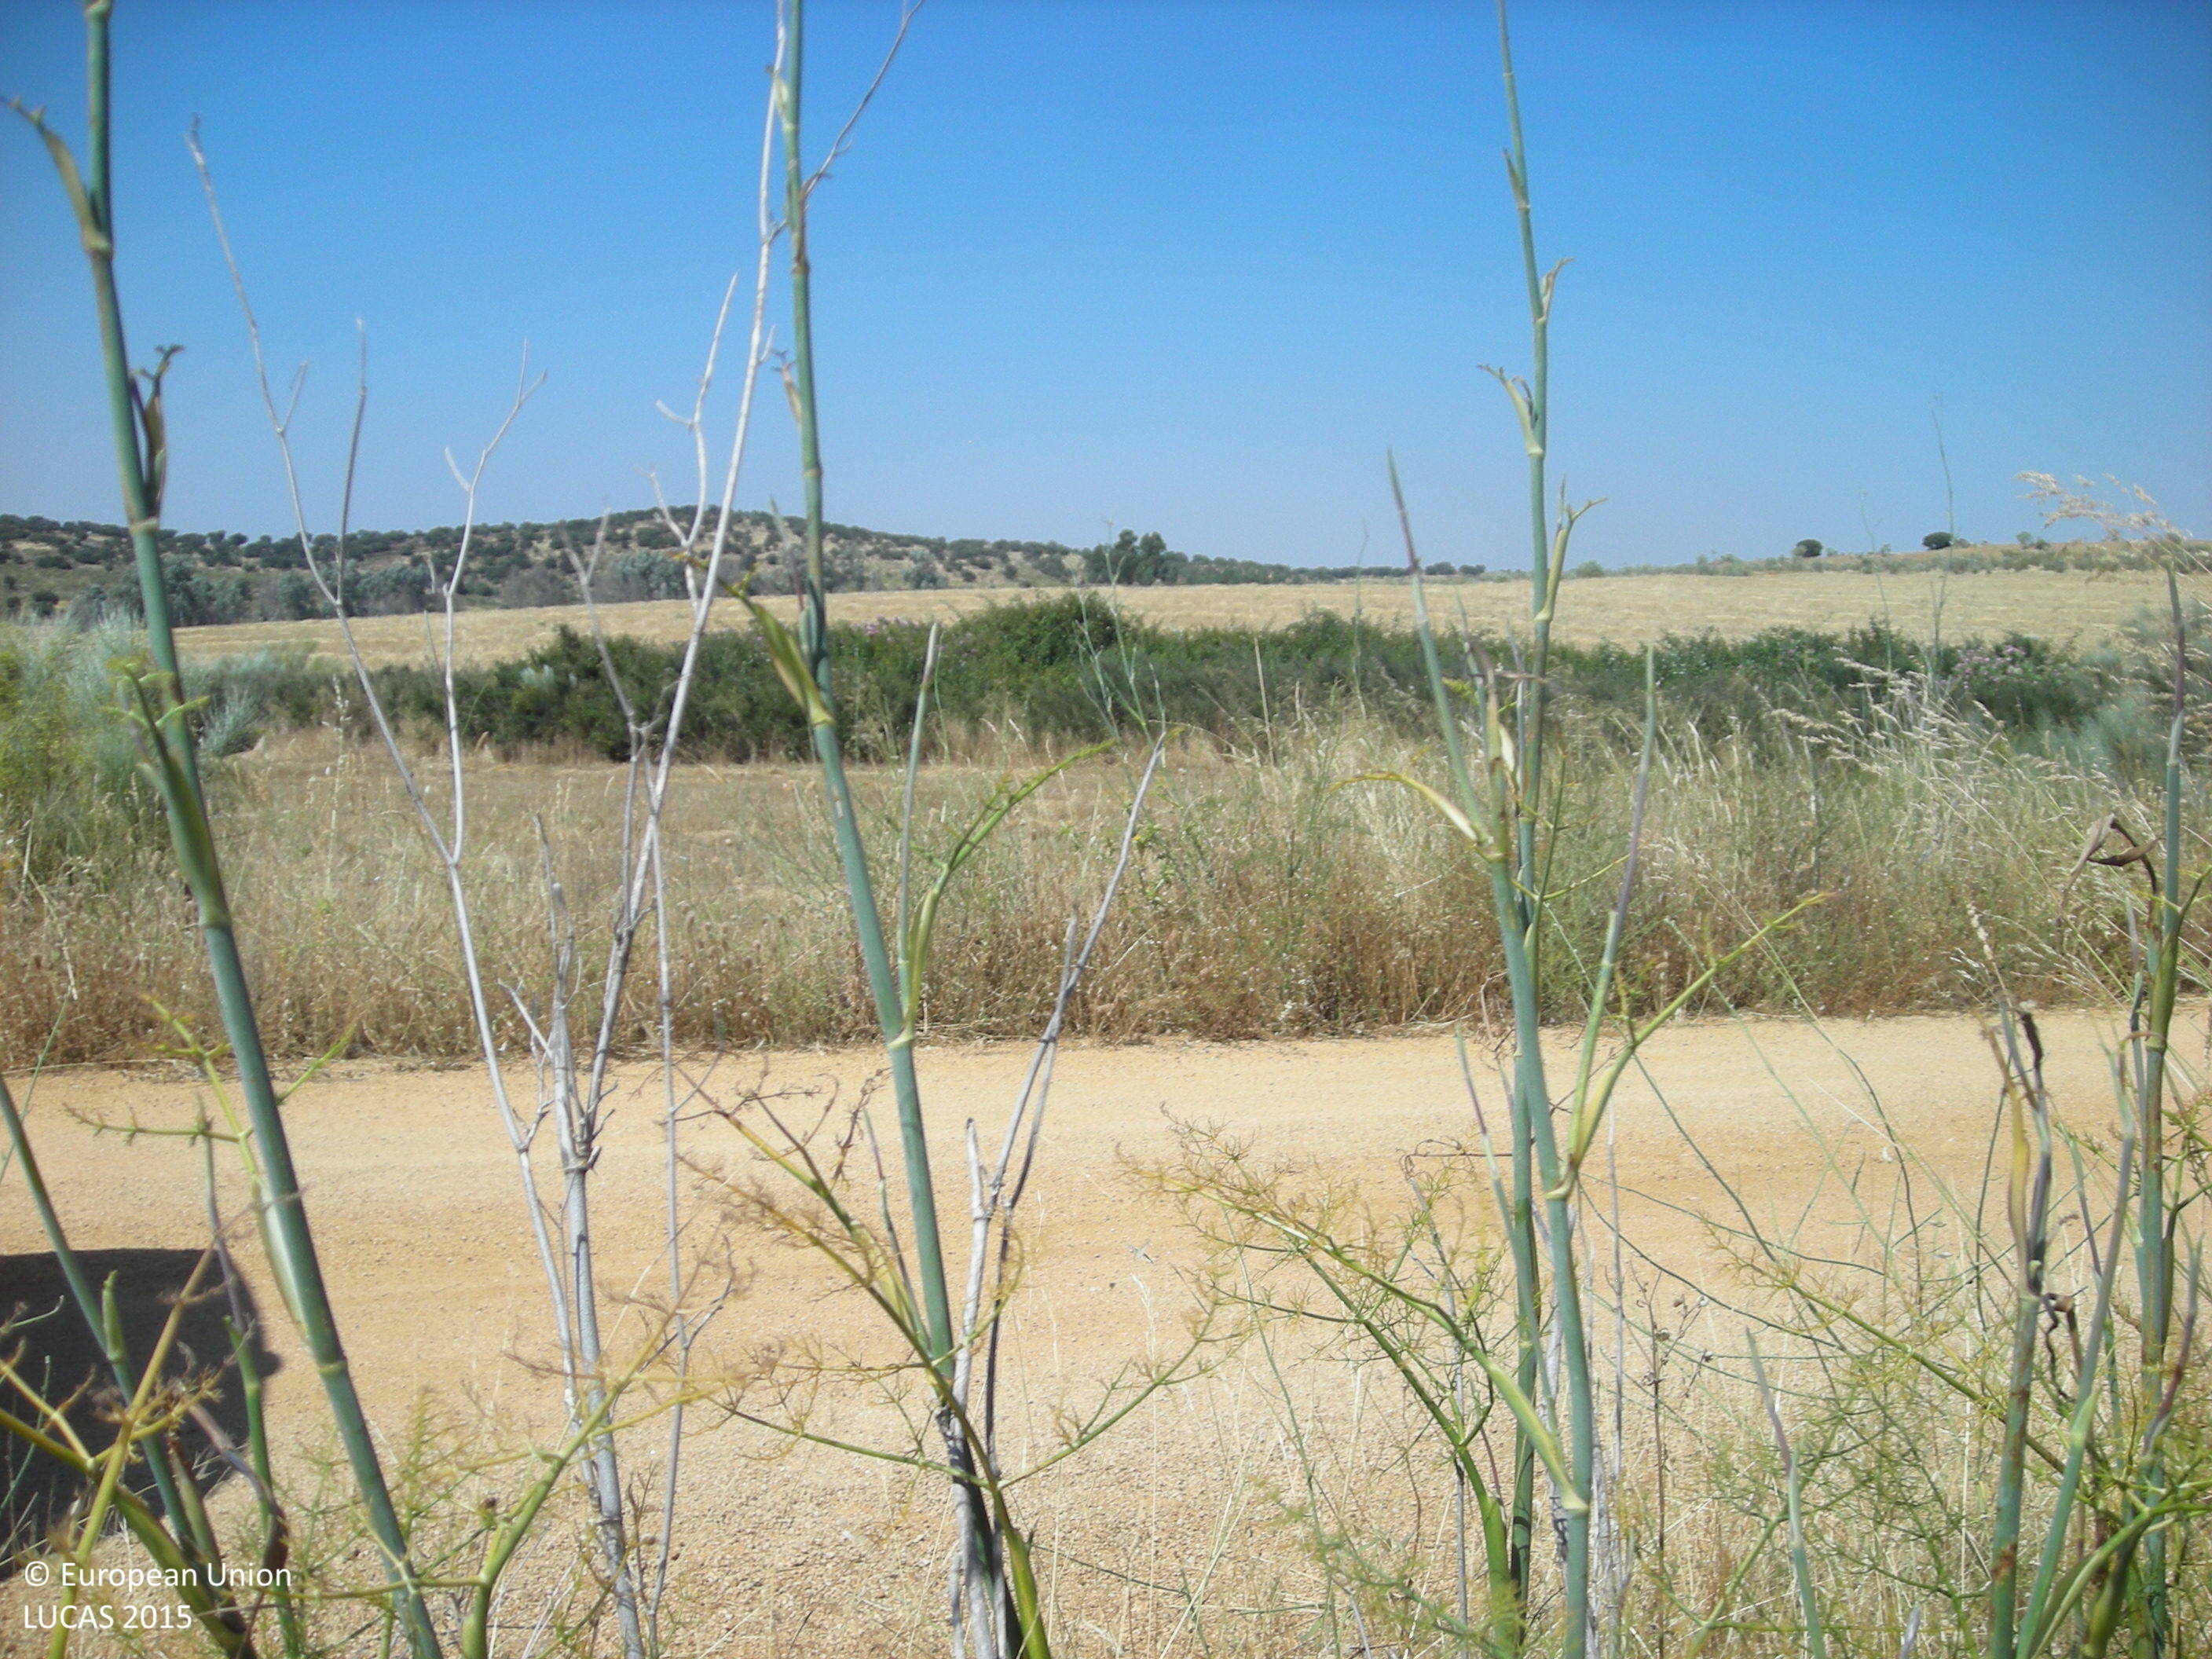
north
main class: Woodland
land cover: Broadleaved woodland
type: broadleaved evergreen forest
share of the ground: 25 - 50 %
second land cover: Grassland without tree/shrub cover
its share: 50 - 75 %
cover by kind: herbaceous plants 60 %, broadleaved forest trees 40 %
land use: Forestry
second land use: Agriculture (excluding fallow land and kitchen gardens)
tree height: > 5 m
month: June
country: ES
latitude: 38.6297
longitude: -5.7913
